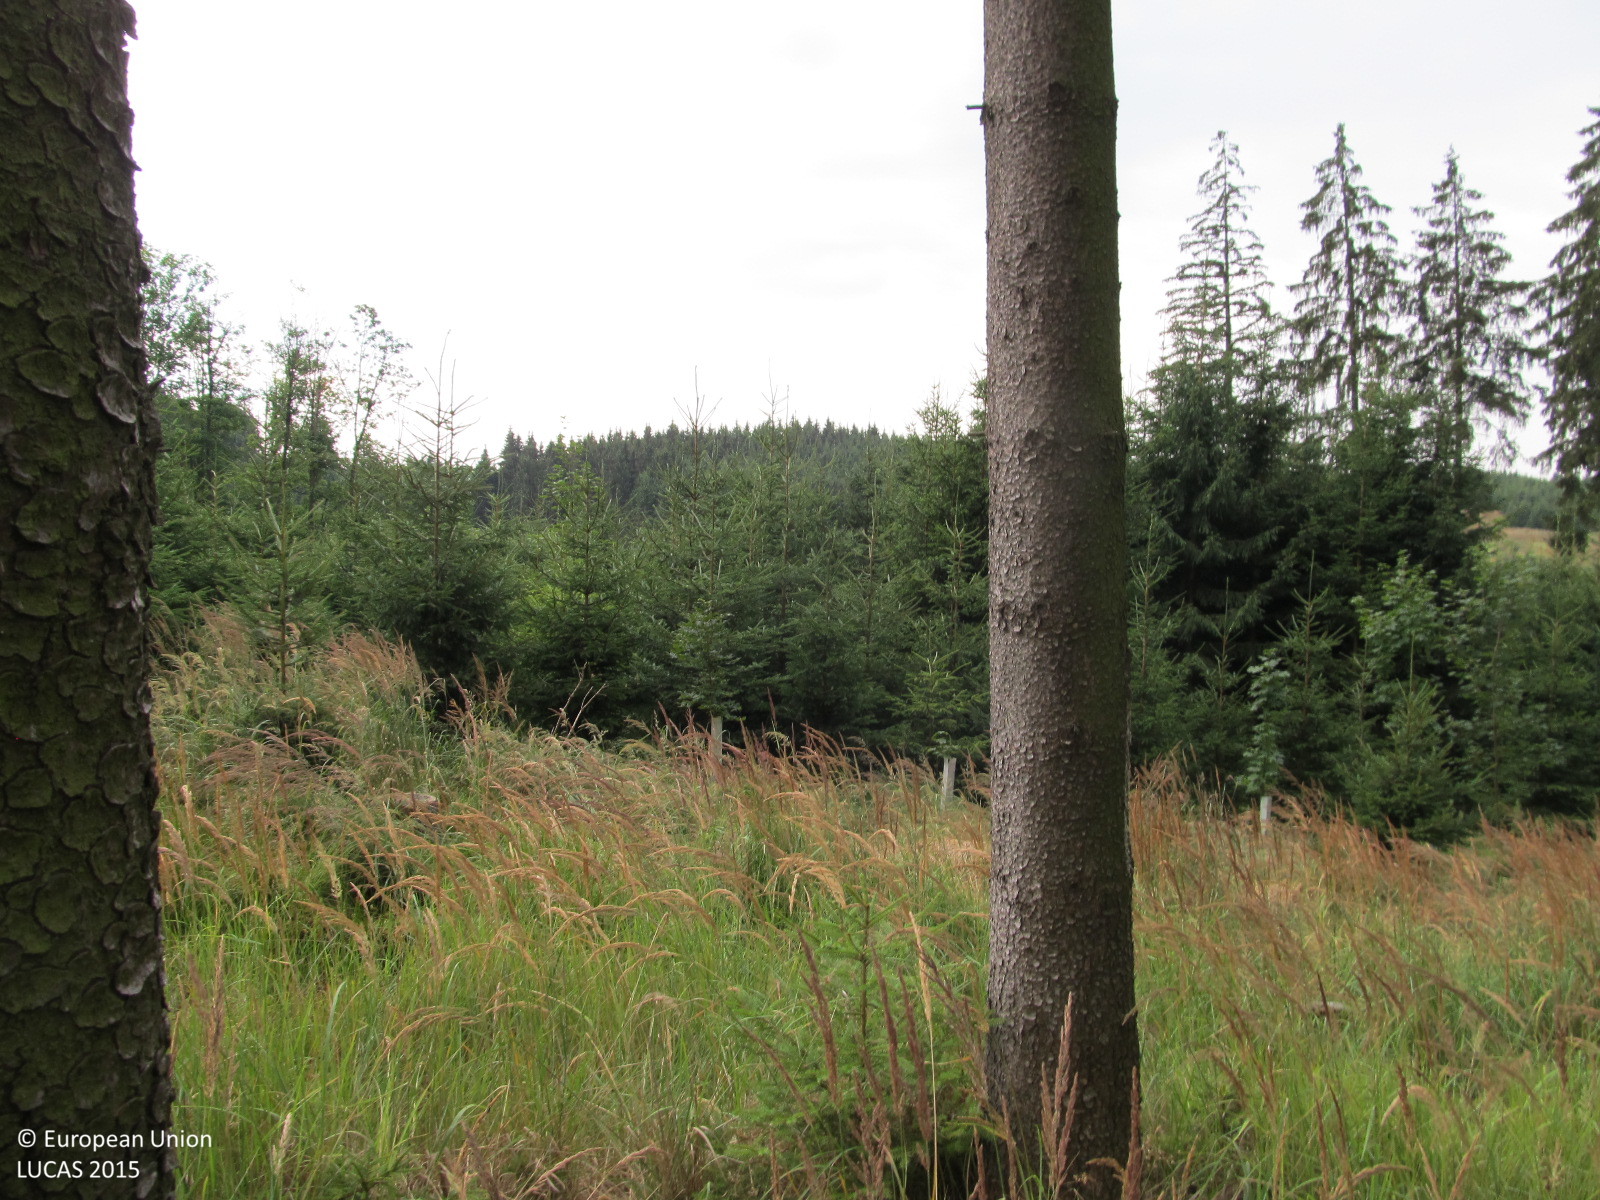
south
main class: Woodland
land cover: Spruce dominated coniferous woodland
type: hemiboreal forest and nemoral coniferous forest and mixed broadleaved-coniferous forest
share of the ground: 50 - 75 %
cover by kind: coniferous forest trees 75 %, herbaceous plants 25 %
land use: Forestry
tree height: > 5 m
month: July
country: AT
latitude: 48.2494
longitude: 15.4836
